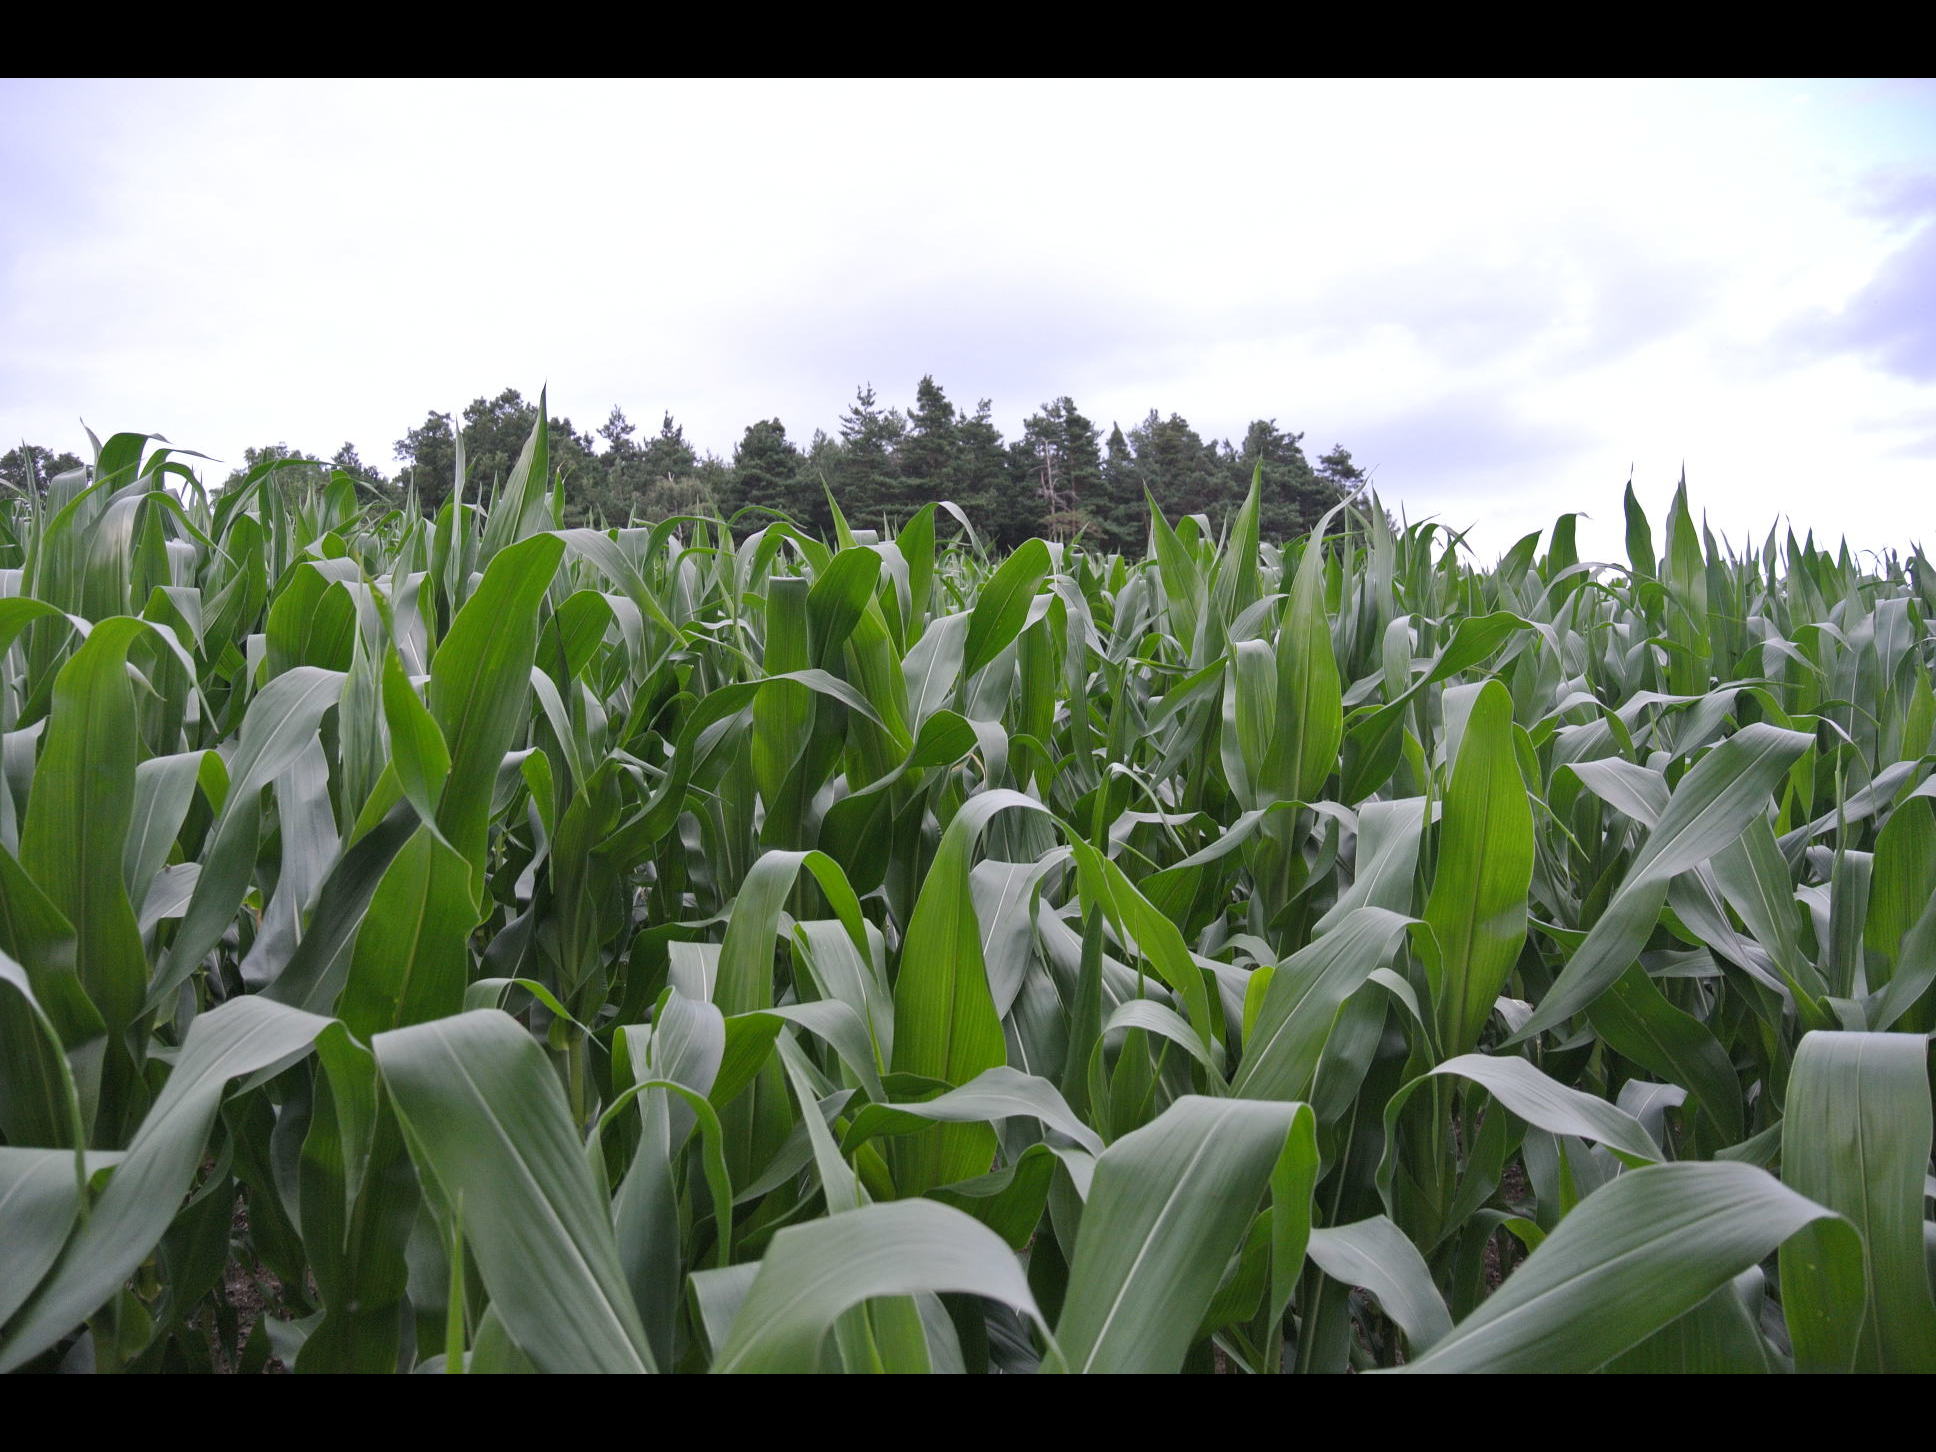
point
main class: Cropland
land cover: Maize
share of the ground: > 75 %
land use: Agriculture (excluding fallow land and kitchen gardens)
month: July
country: AT
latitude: 47.6702
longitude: 16.1962
